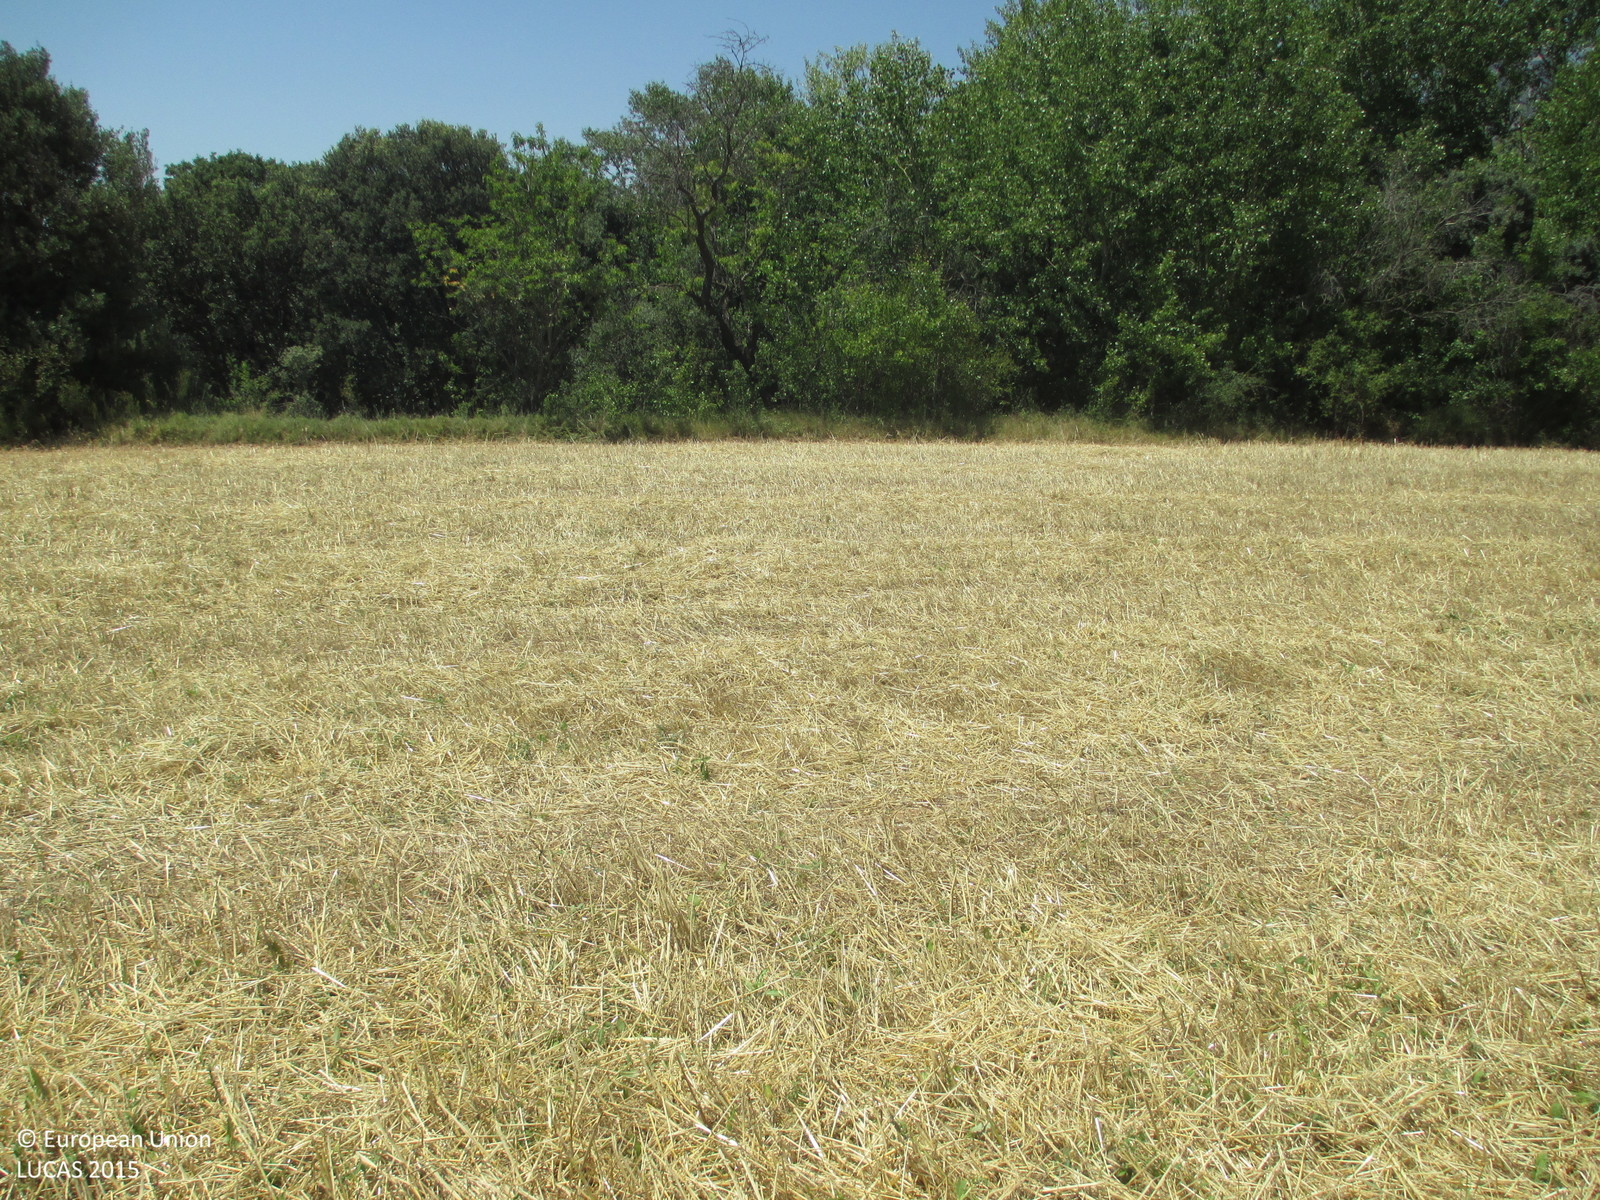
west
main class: Cropland
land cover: Barley
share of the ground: < 10 %
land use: Agriculture (excluding fallow land and kitchen gardens)
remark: Harvested field
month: June
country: ES
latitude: 42.2590
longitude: -0.4366
